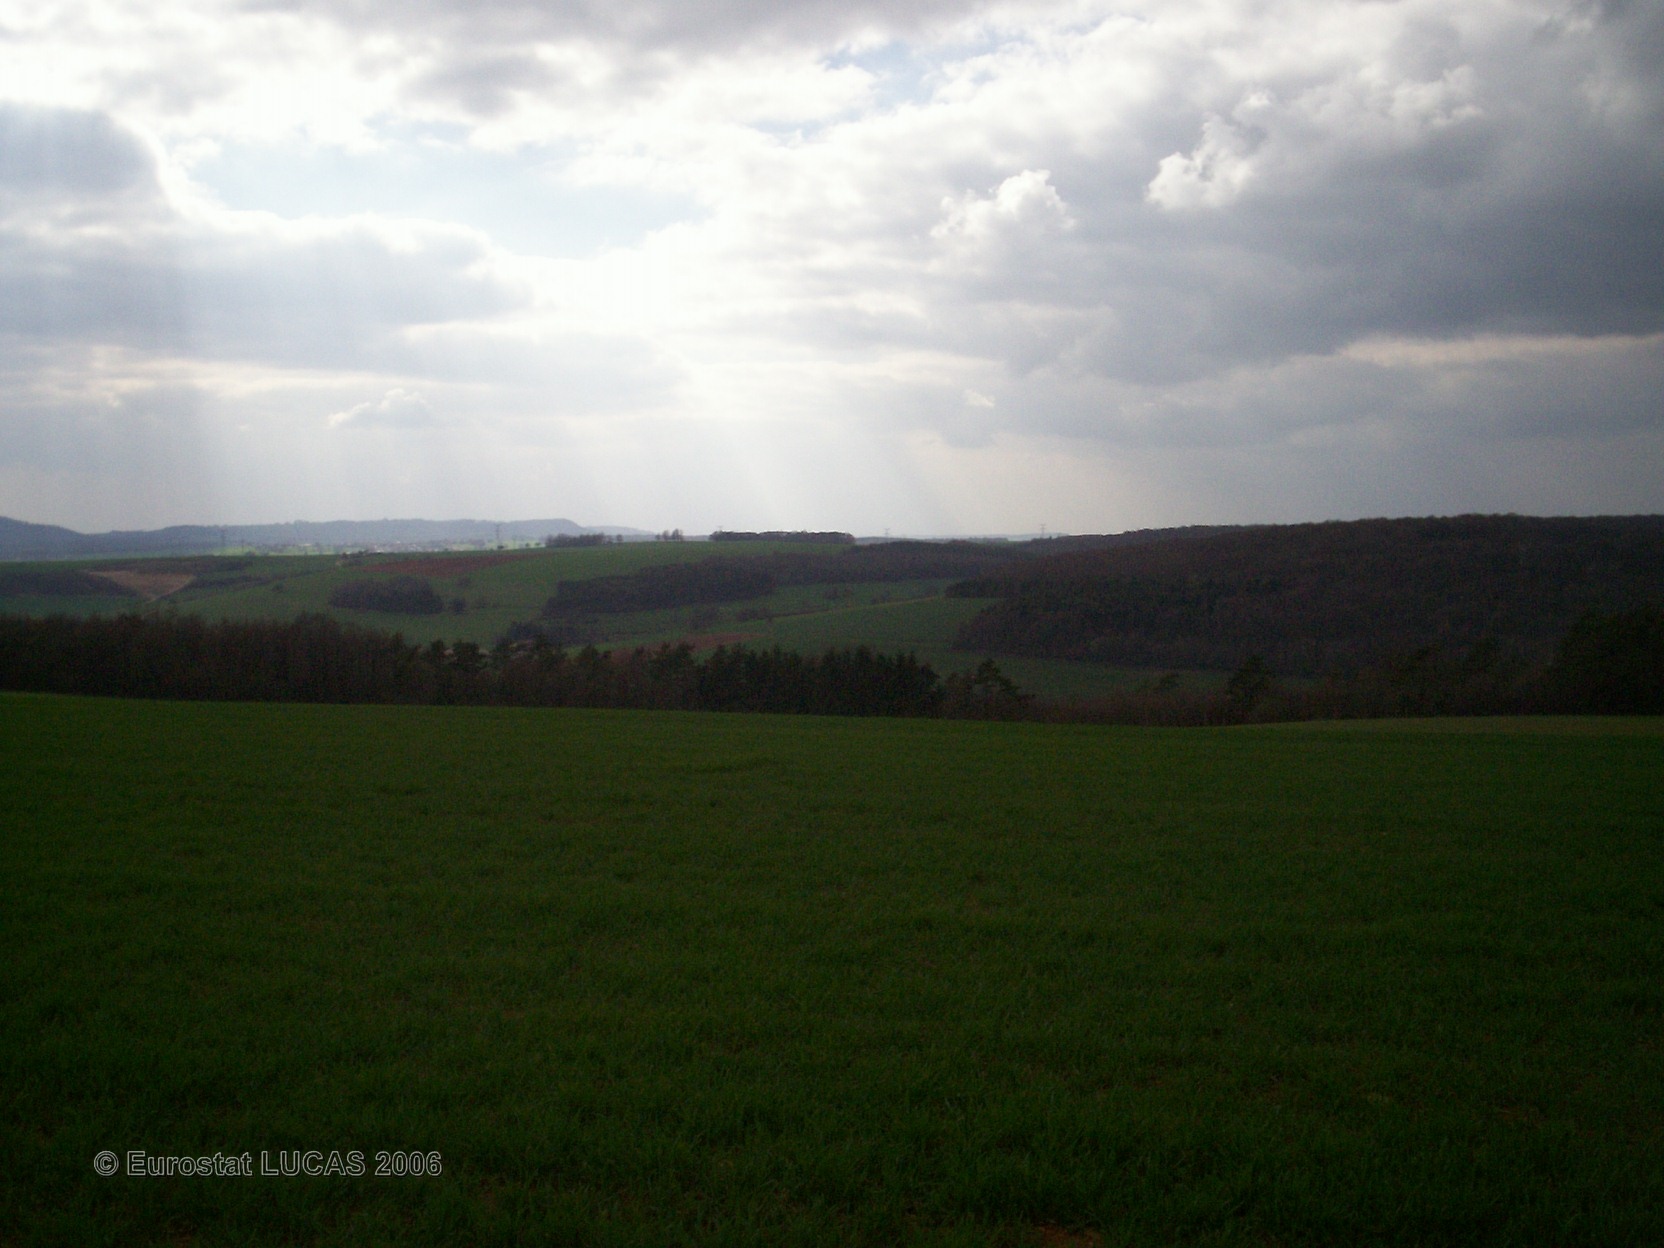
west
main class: Cropland
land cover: Common wheat
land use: Agriculture (excluding fallow land and kitchen gardens)
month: April
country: FR
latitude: 49.5716
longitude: 5.0332
